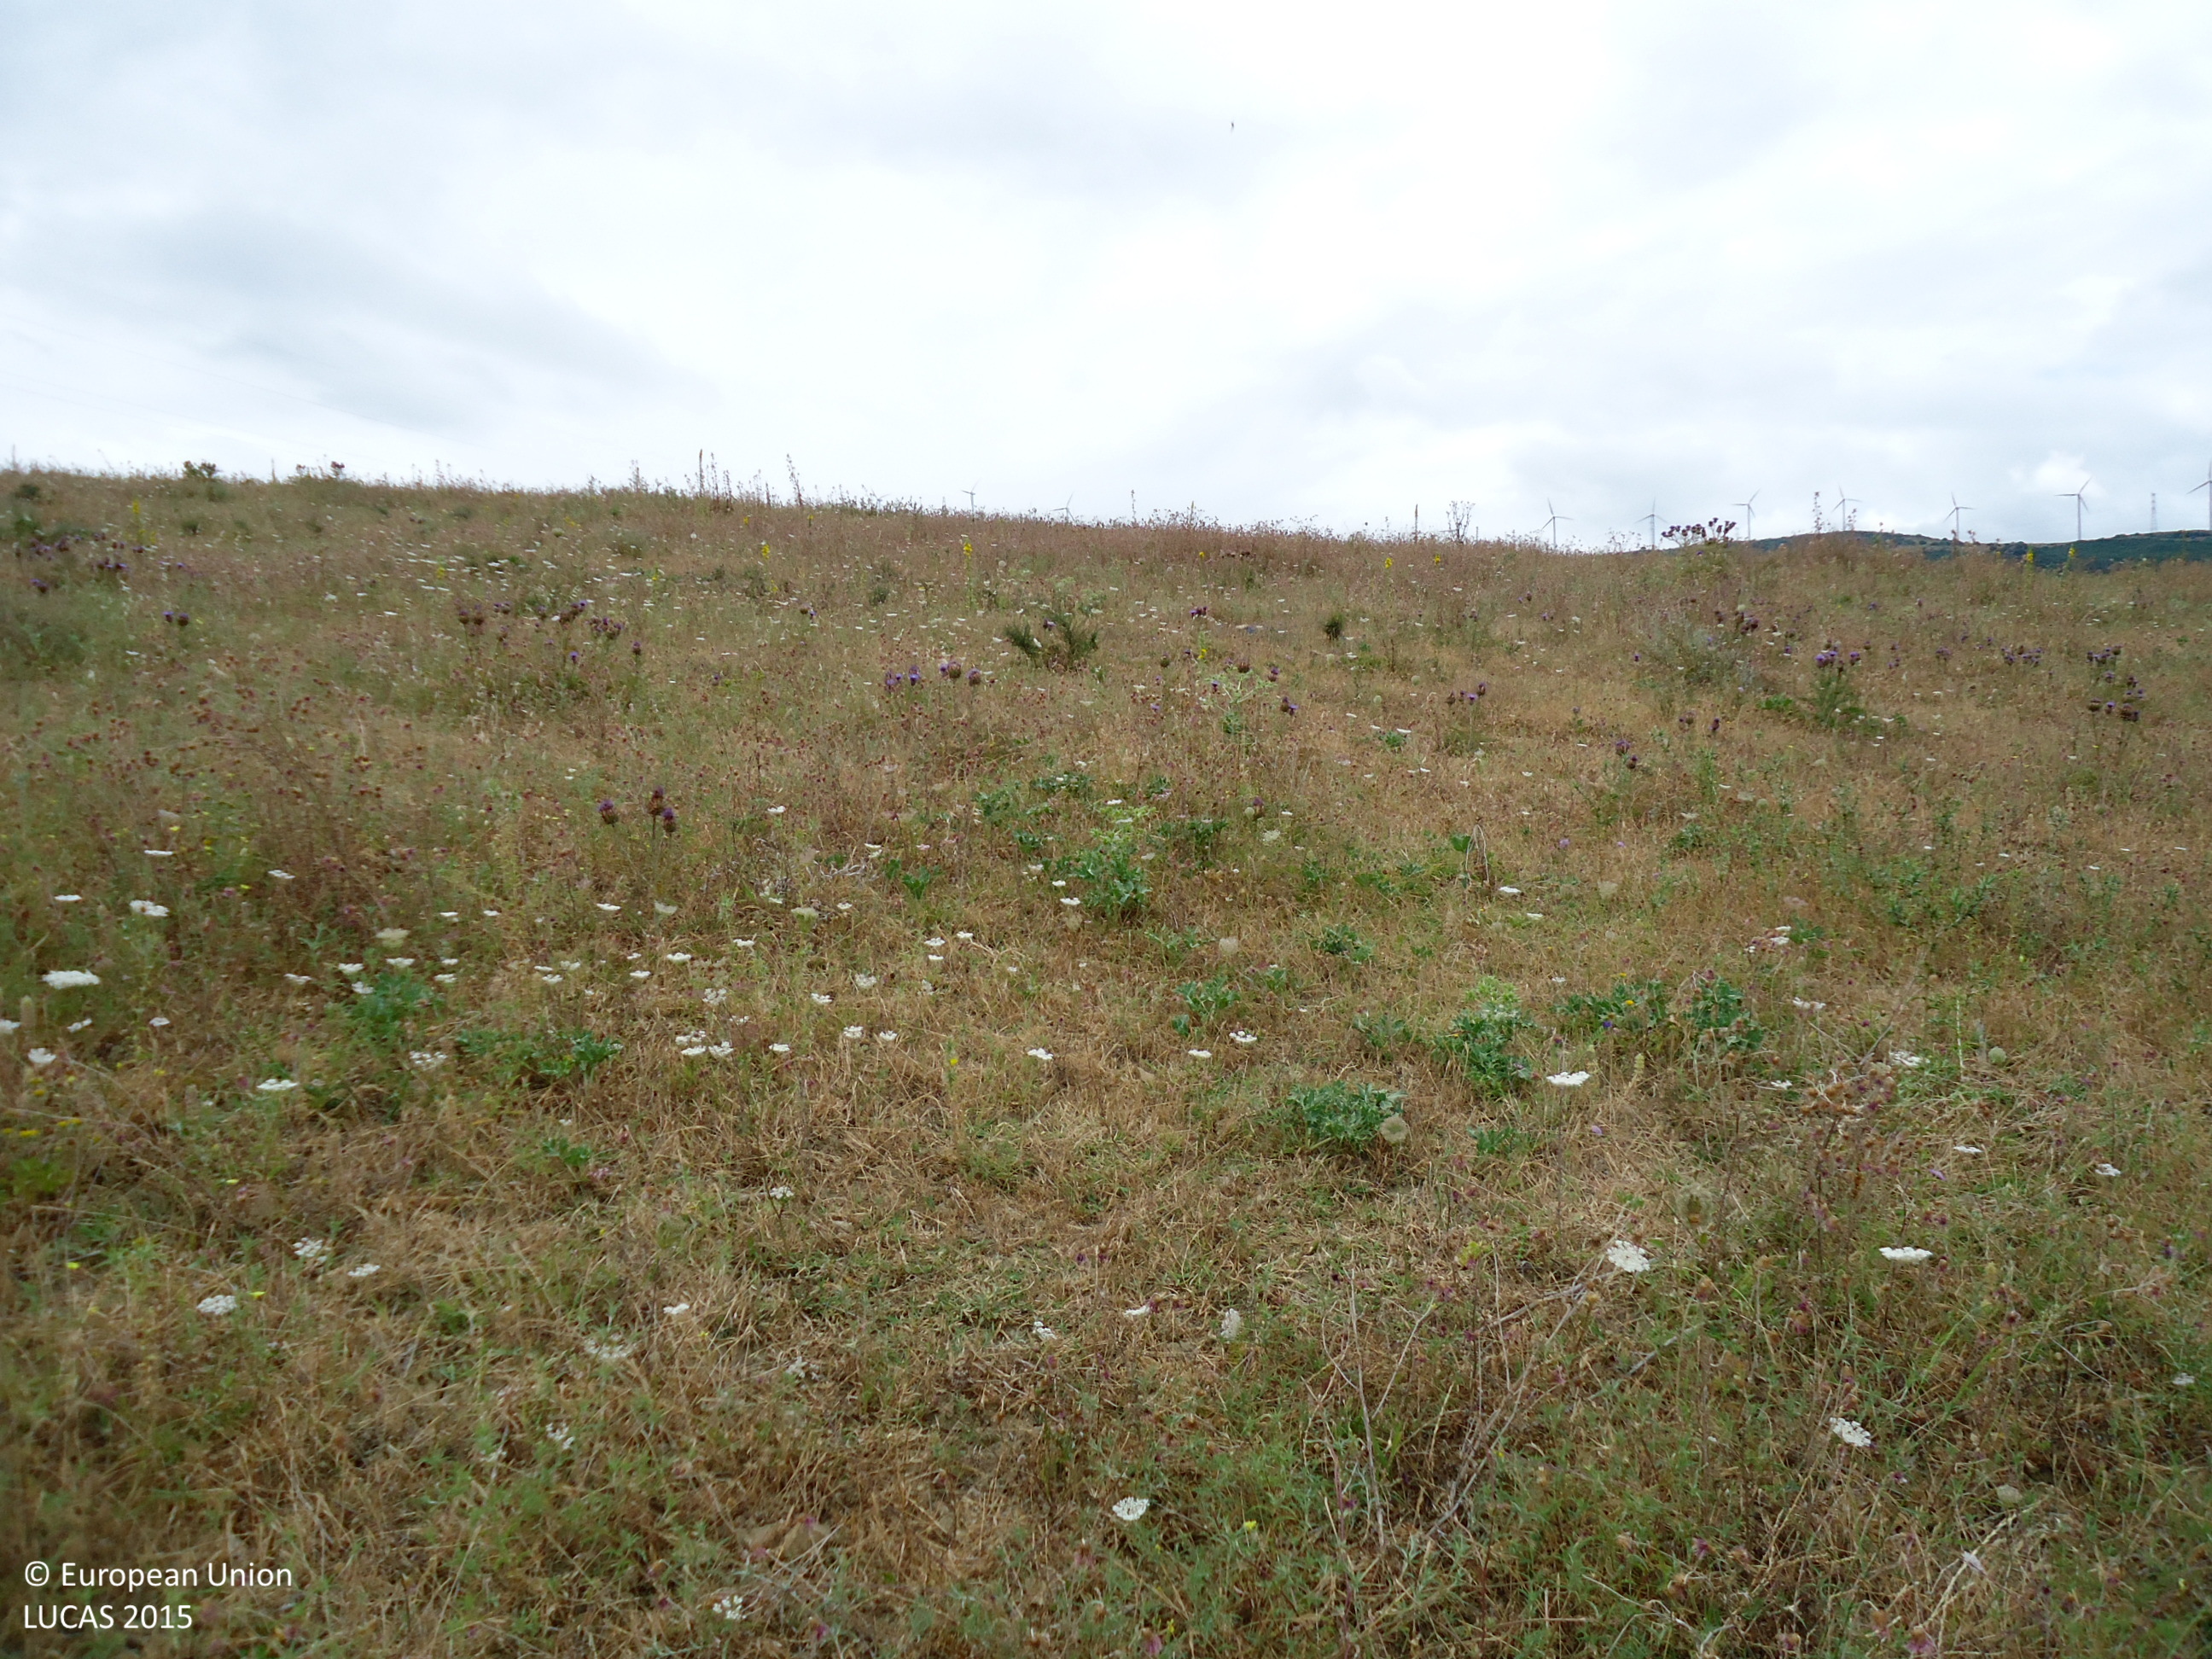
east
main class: Grassland
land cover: Spontaneously vegetated surfaces
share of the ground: > 75 %
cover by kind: herbaceous plants 100 %
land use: Agriculture (excluding fallow land and kitchen gardens)
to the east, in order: Spontaneously vegetated surfaces; Rivers and streams; Spontaneously vegetated surfaces; Rivers and streams; Spontaneously vegetated surfaces
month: June
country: ES
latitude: 36.4085
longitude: -5.3053
